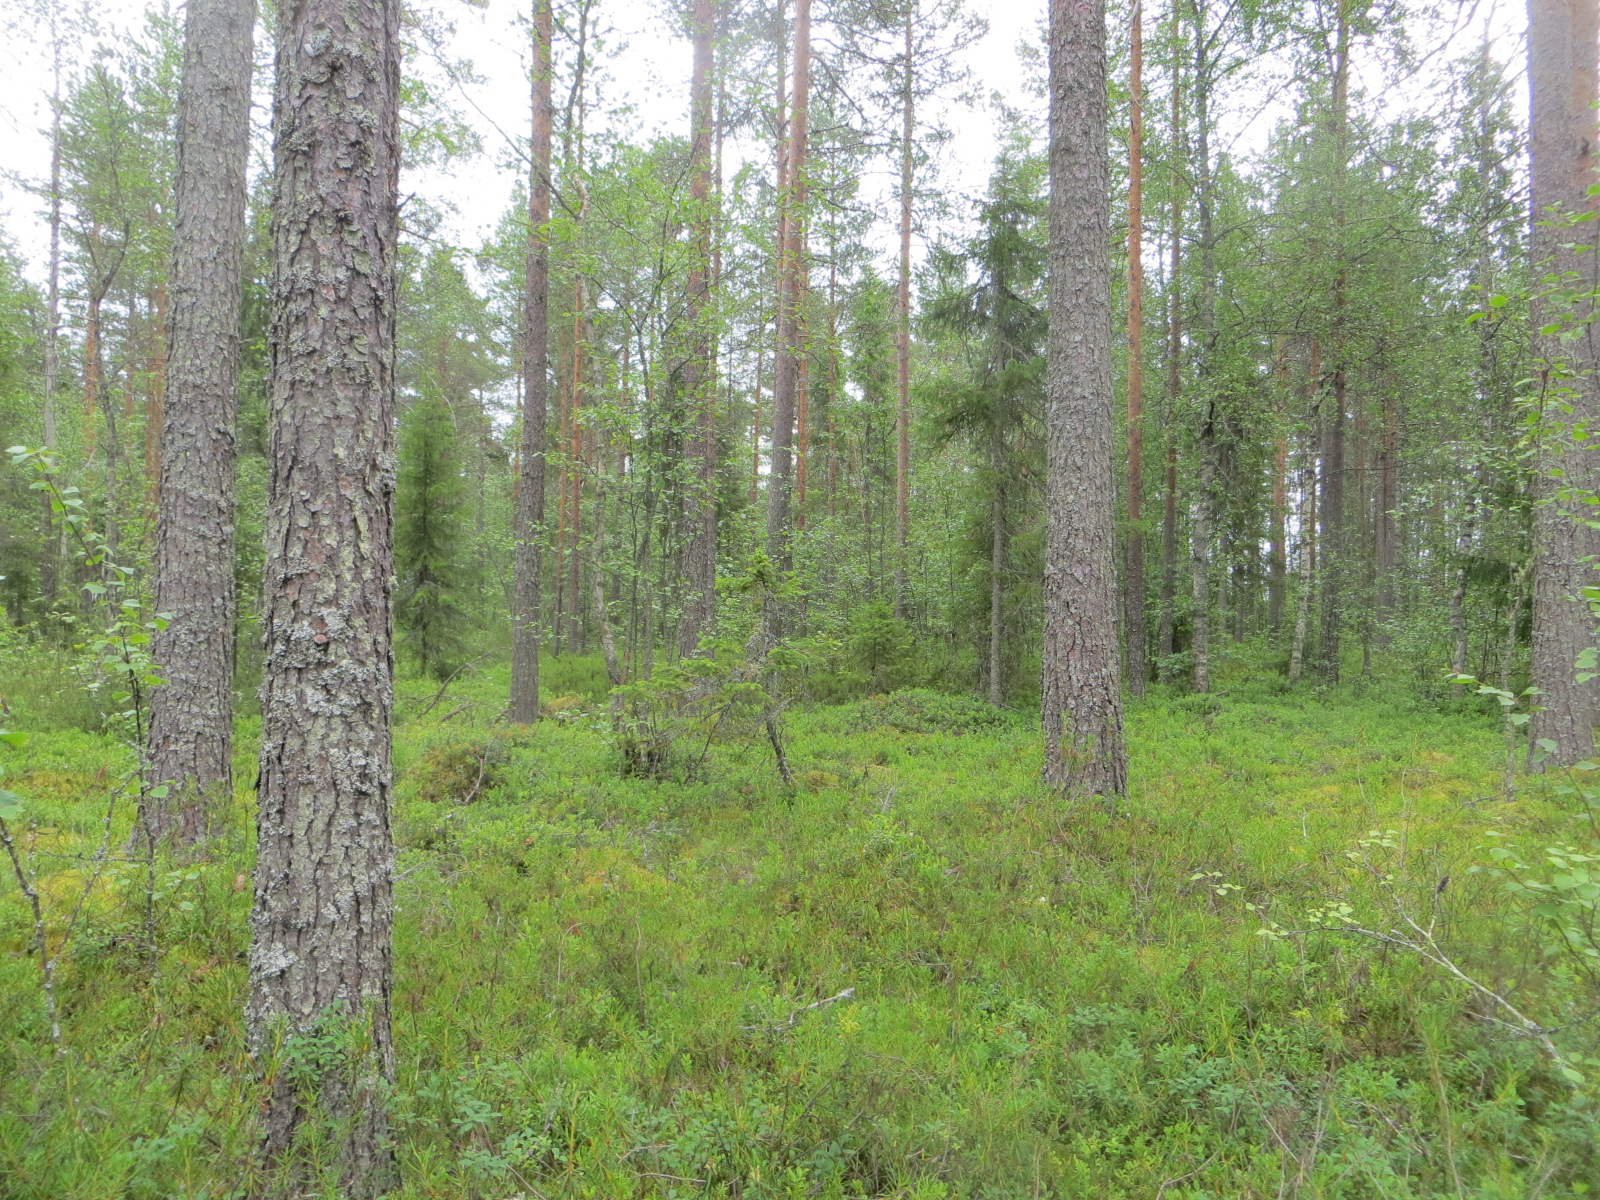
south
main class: Woodland
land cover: Other coniferous woodland
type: boreal forest
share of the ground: 50 - 75 %
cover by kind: coniferous forest trees 60 %, shrubs 30 %, broadleaved forest trees 10 %
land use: Forestry
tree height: > 5 m
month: July
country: FI
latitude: 65.6189
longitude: 25.2014
